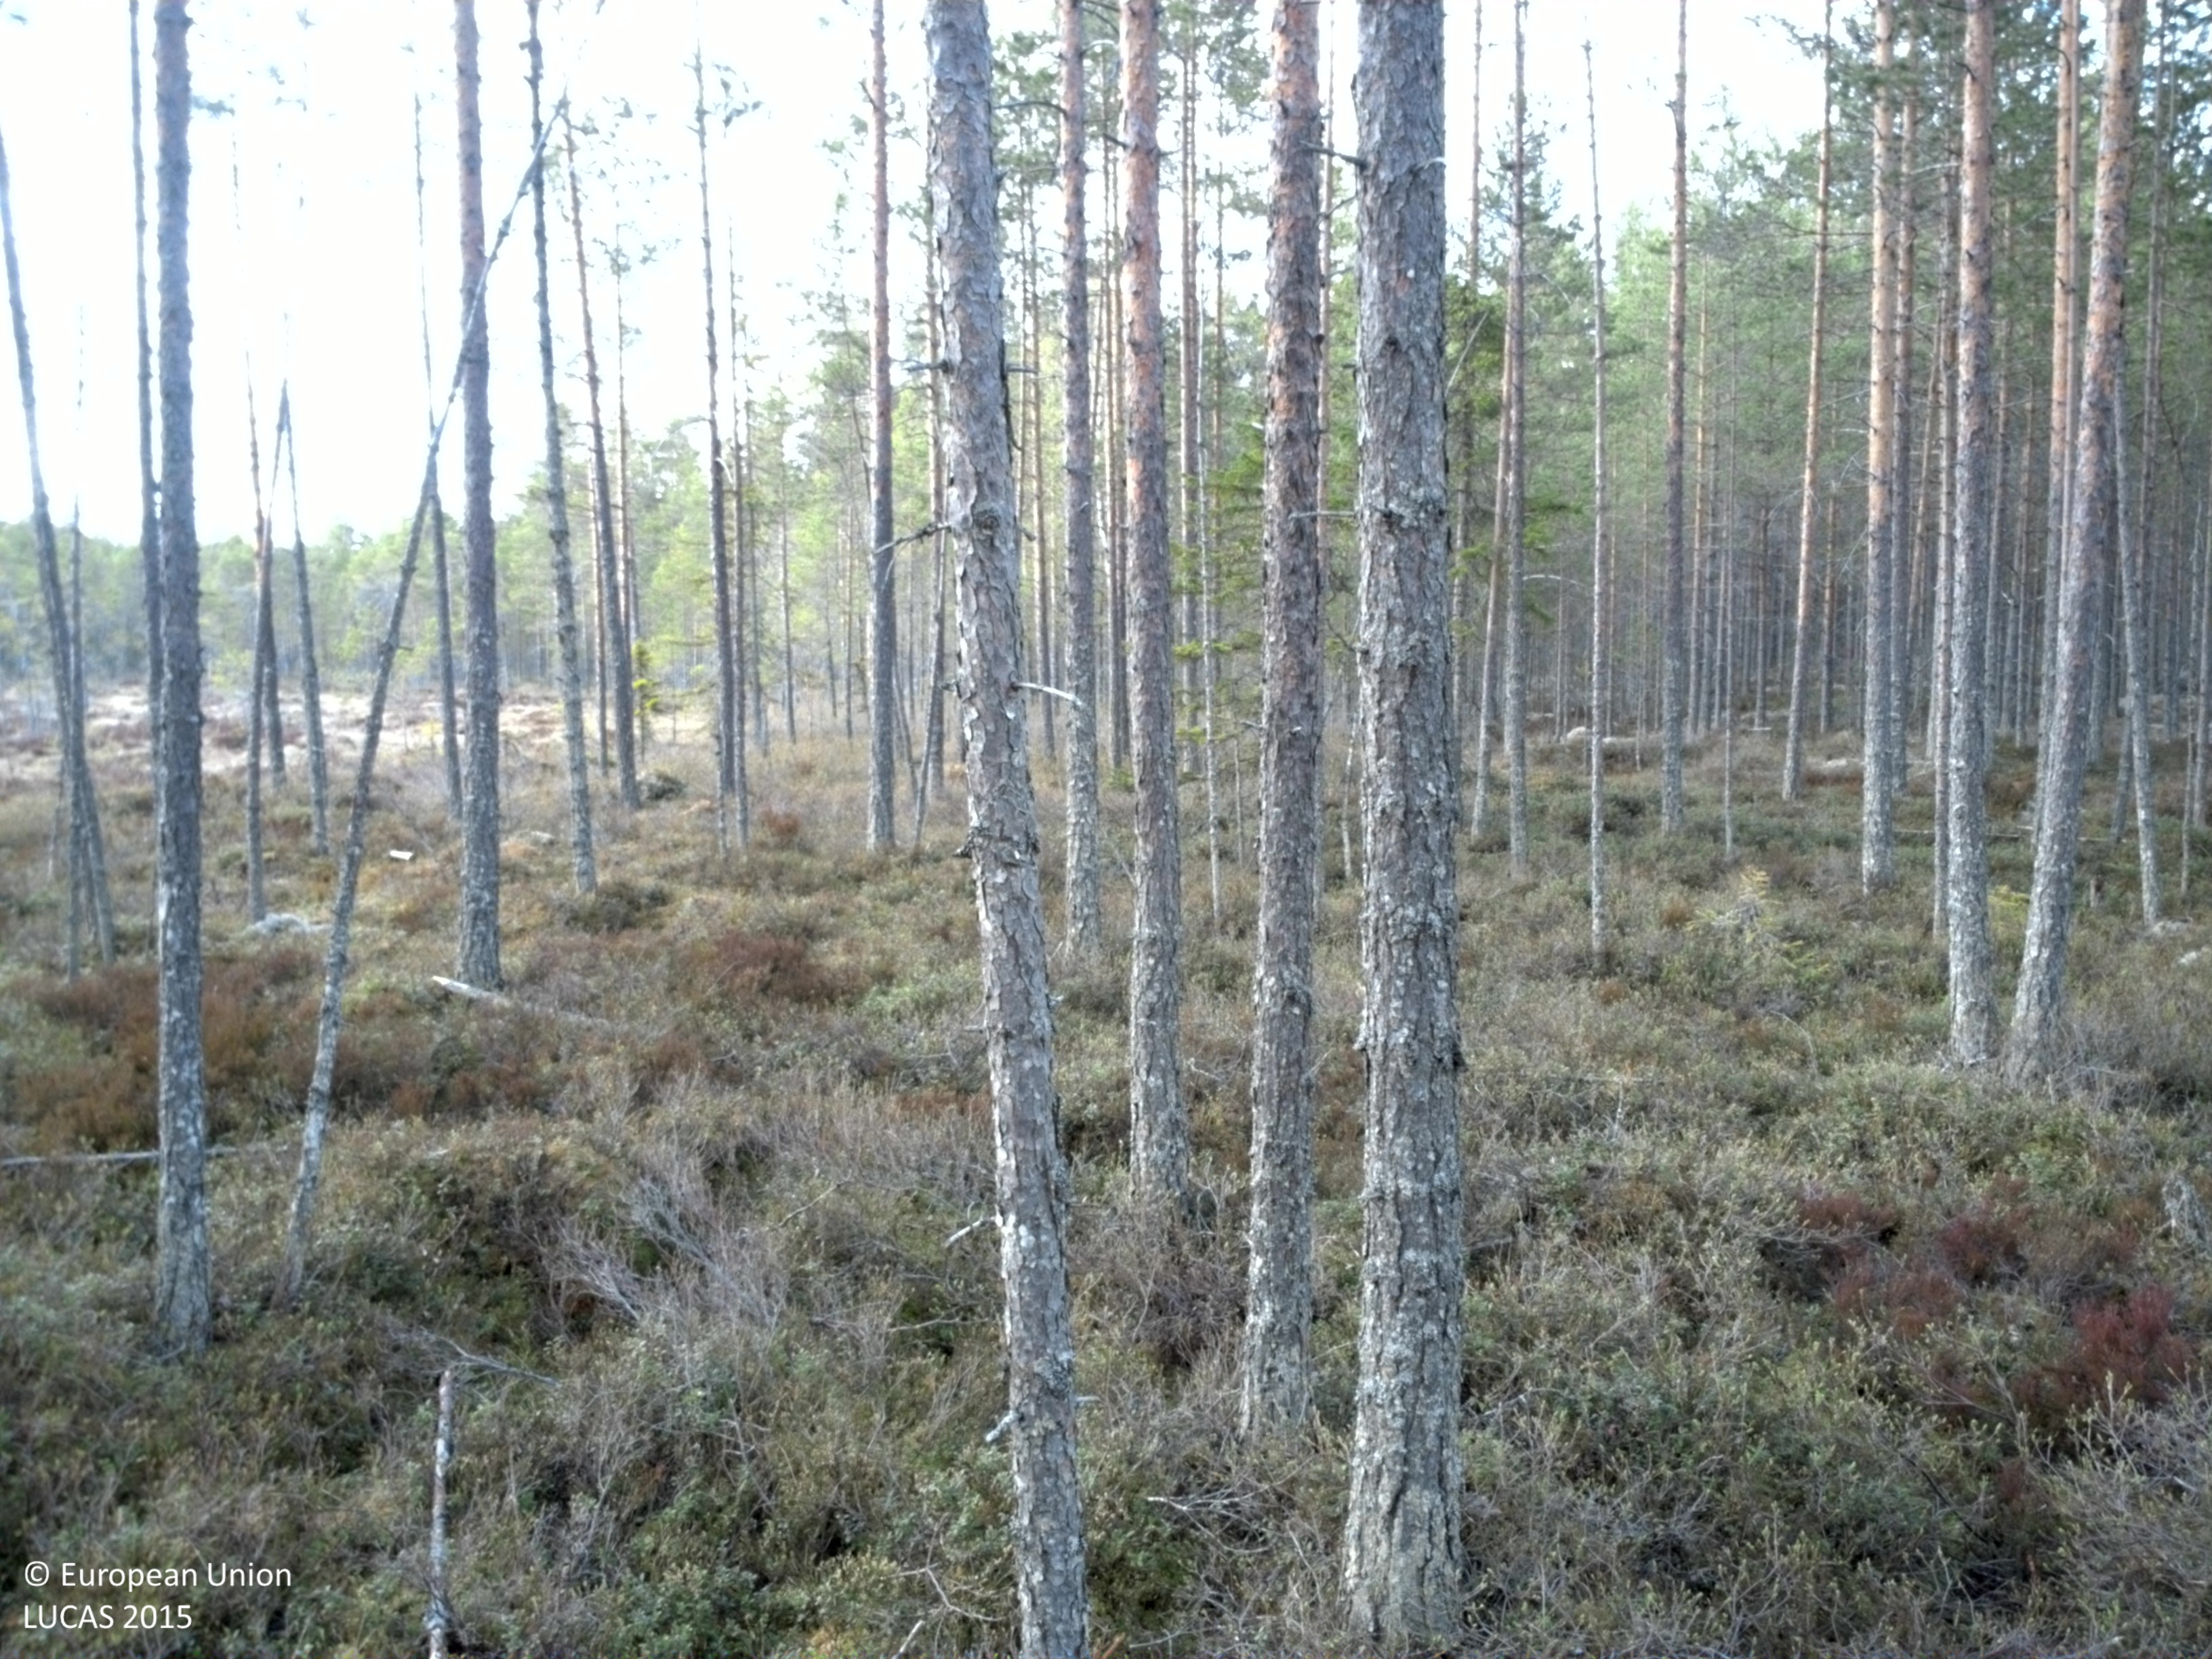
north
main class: Woodland
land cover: Pine dominated coniferous woodland
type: boreal forest
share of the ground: > 75 %
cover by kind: coniferous forest trees 80 %, shrubs 20 %
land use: Forestry
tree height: > 5 m
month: May
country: SE
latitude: 61.1535
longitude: 15.0952
